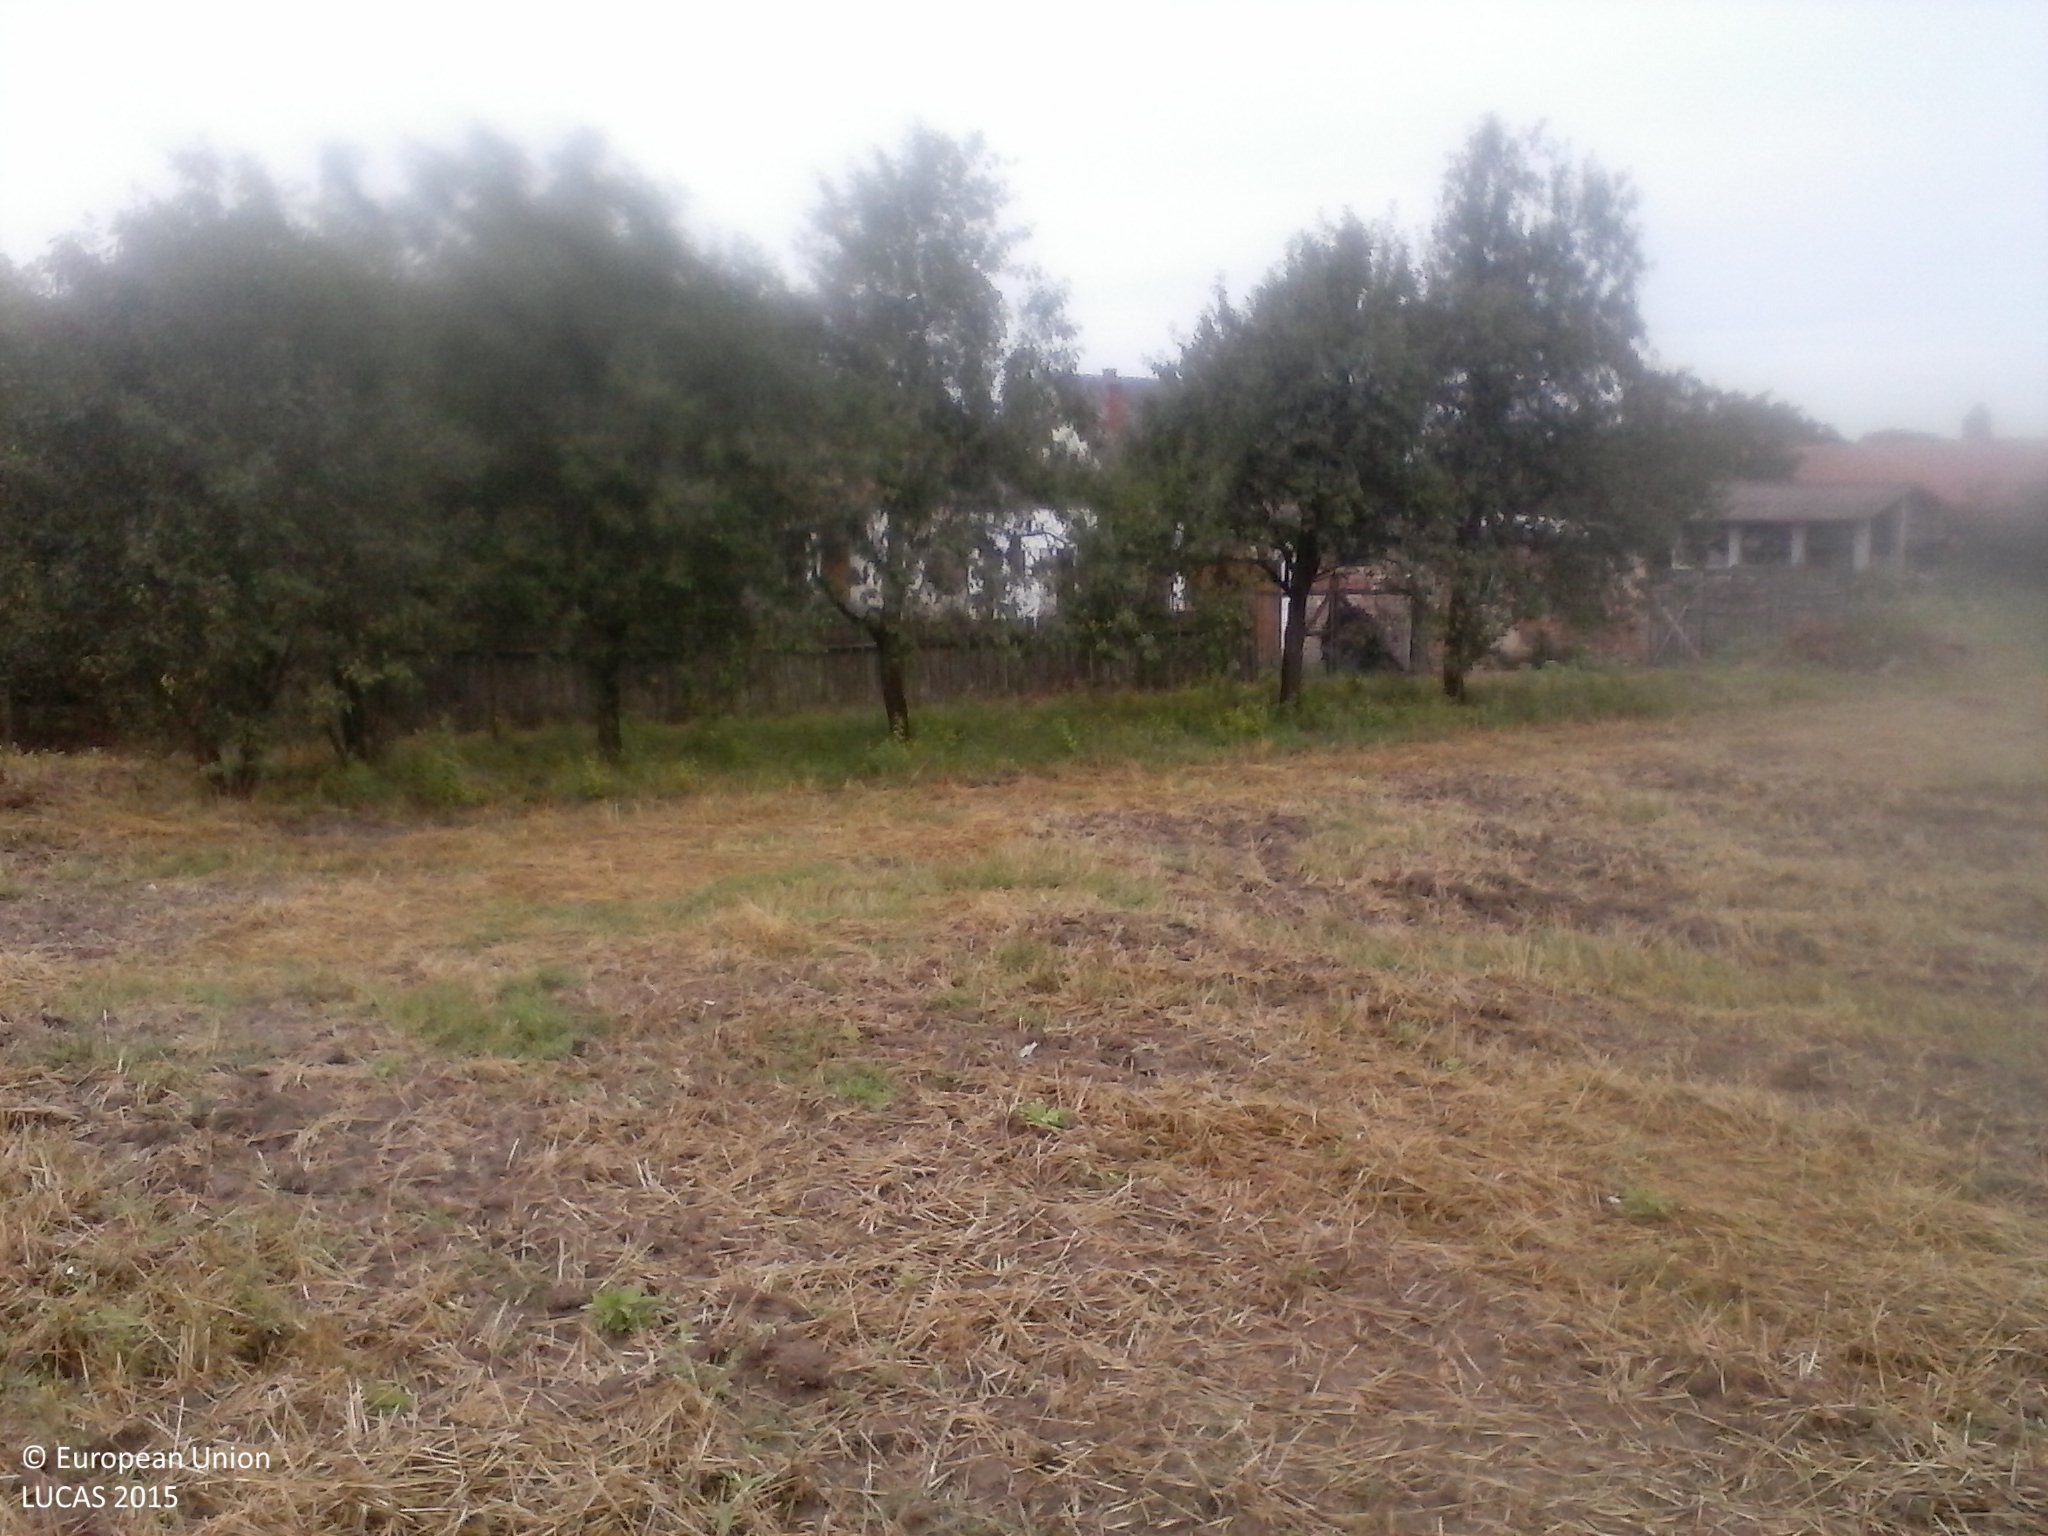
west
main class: Cropland
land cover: Common wheat
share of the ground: < 10 %
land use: Agriculture (excluding fallow land and kitchen gardens)
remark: Harvested field
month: July
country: HU
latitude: 45.9445
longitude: 17.7309
